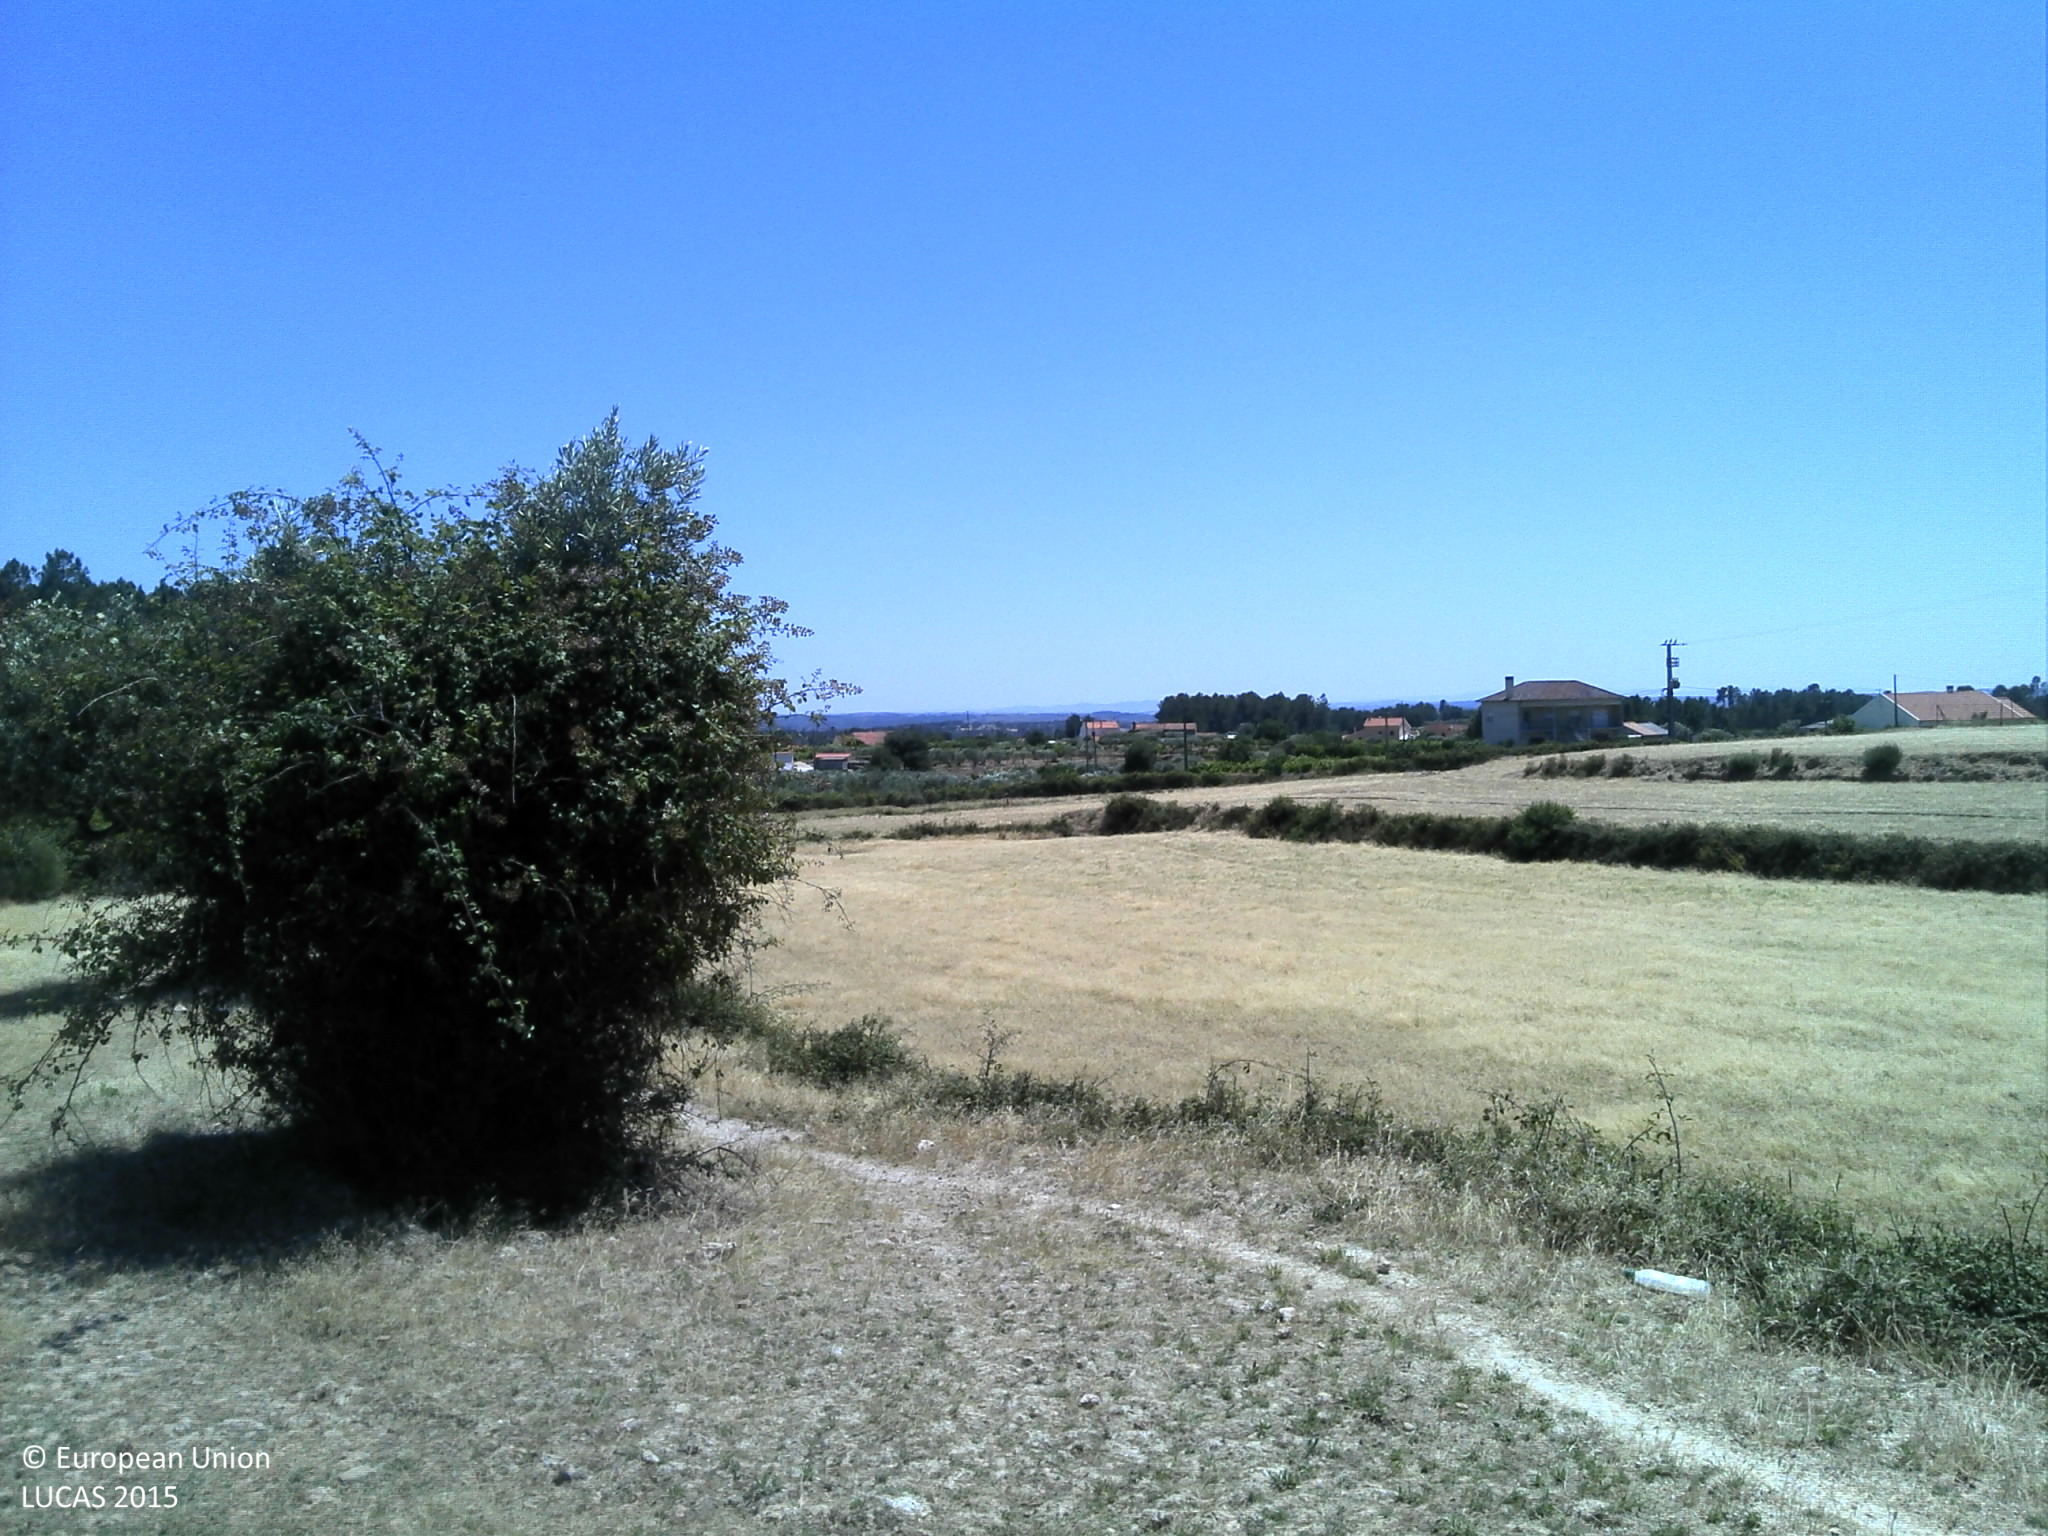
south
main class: Grassland
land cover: Grassland without tree/shrub cover
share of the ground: 25 - 50 %
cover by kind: unconsolidated bare surface 50 %, herbaceous plants 40 %
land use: Agriculture (excluding fallow land and kitchen gardens)
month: June
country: PT
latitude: 40.1049
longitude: -7.3814
